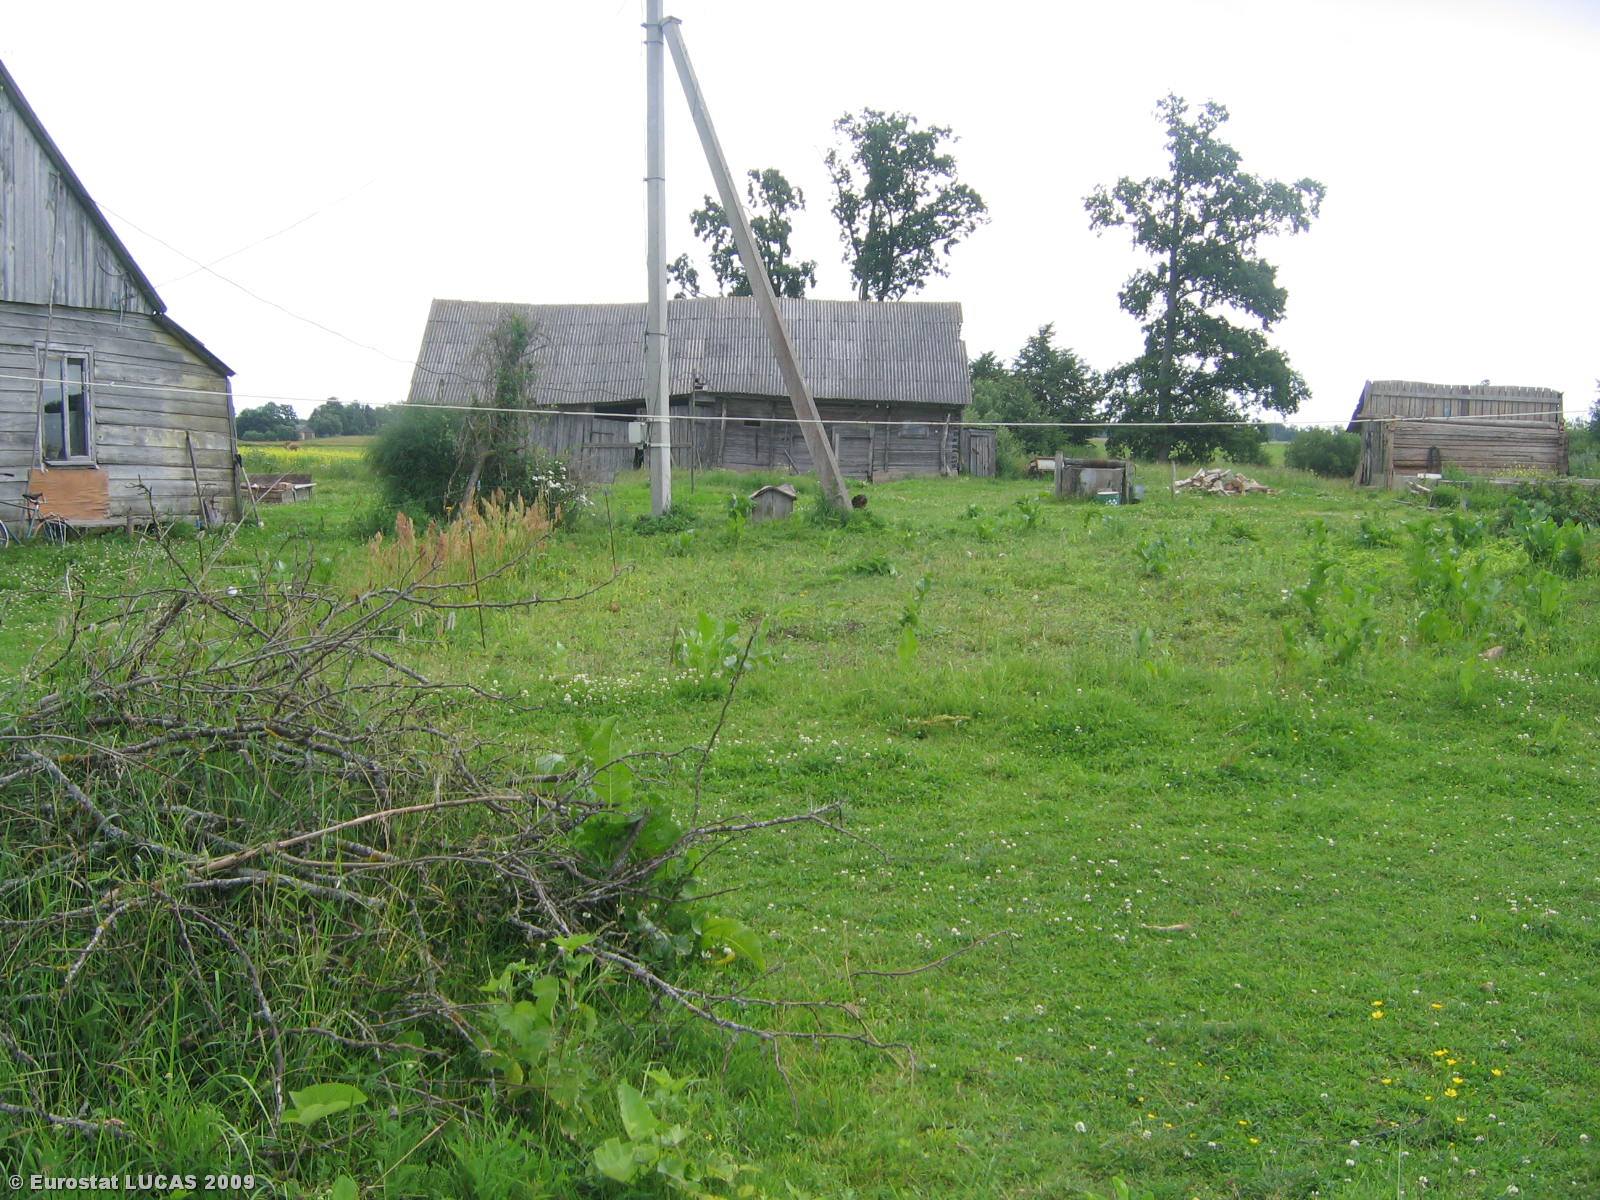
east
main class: Grassland
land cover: Grassland with sparse tree/shrub cover
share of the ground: > 75 %
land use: Residential
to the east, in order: Grassland with sparse tree/shrub cover; Electric lines; Artificial constructions in urban areas; Broadleaved woodland; Spontaneously vegetated surfaces; Bare land; Grassland without tree/shrub cover
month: July
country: LT
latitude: 55.2763
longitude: 22.7376
